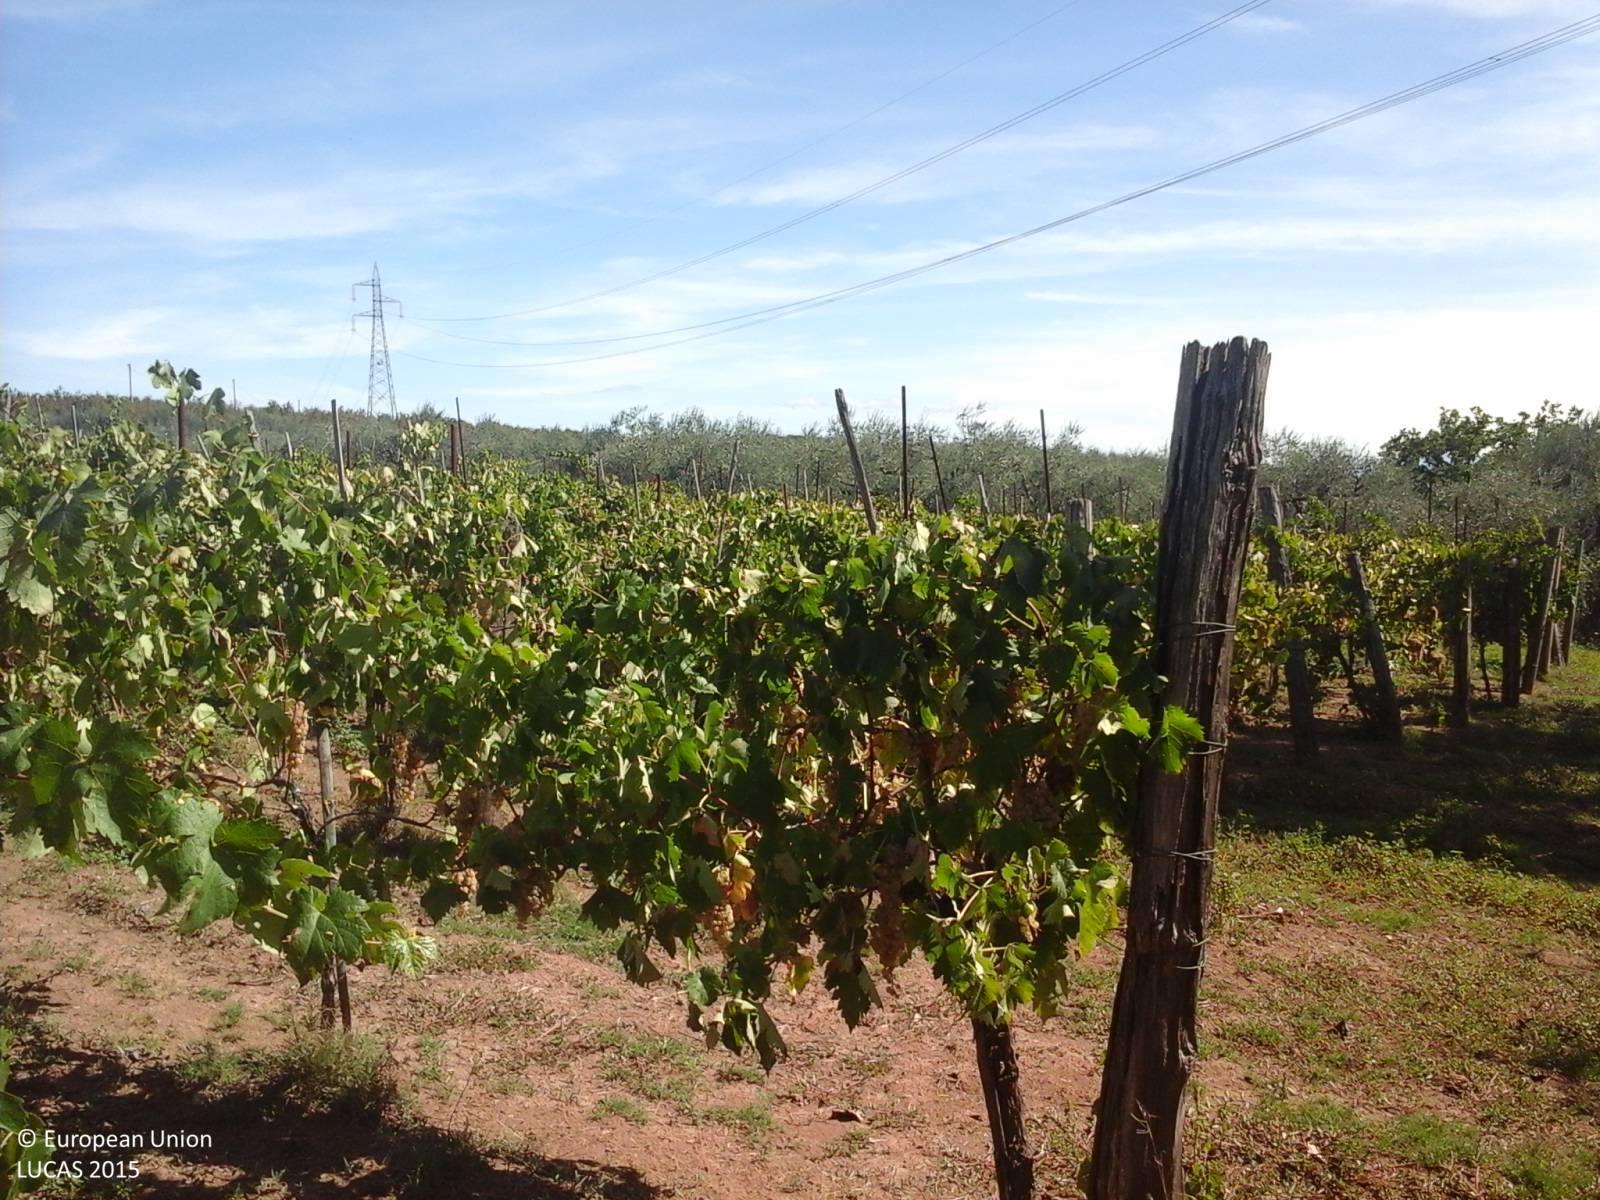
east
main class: Cropland
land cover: Vineyards
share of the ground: > 75 %
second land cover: Other bare soil
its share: > 75 %
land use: Agriculture (excluding fallow land and kitchen gardens)
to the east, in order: Vineyards; Other bare soil; Olive groves; Nuts trees; Fences; Olive groves; Artificial constructions in urban areas; Nuts trees
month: September
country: IT
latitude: 42.3566
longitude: 12.3110
